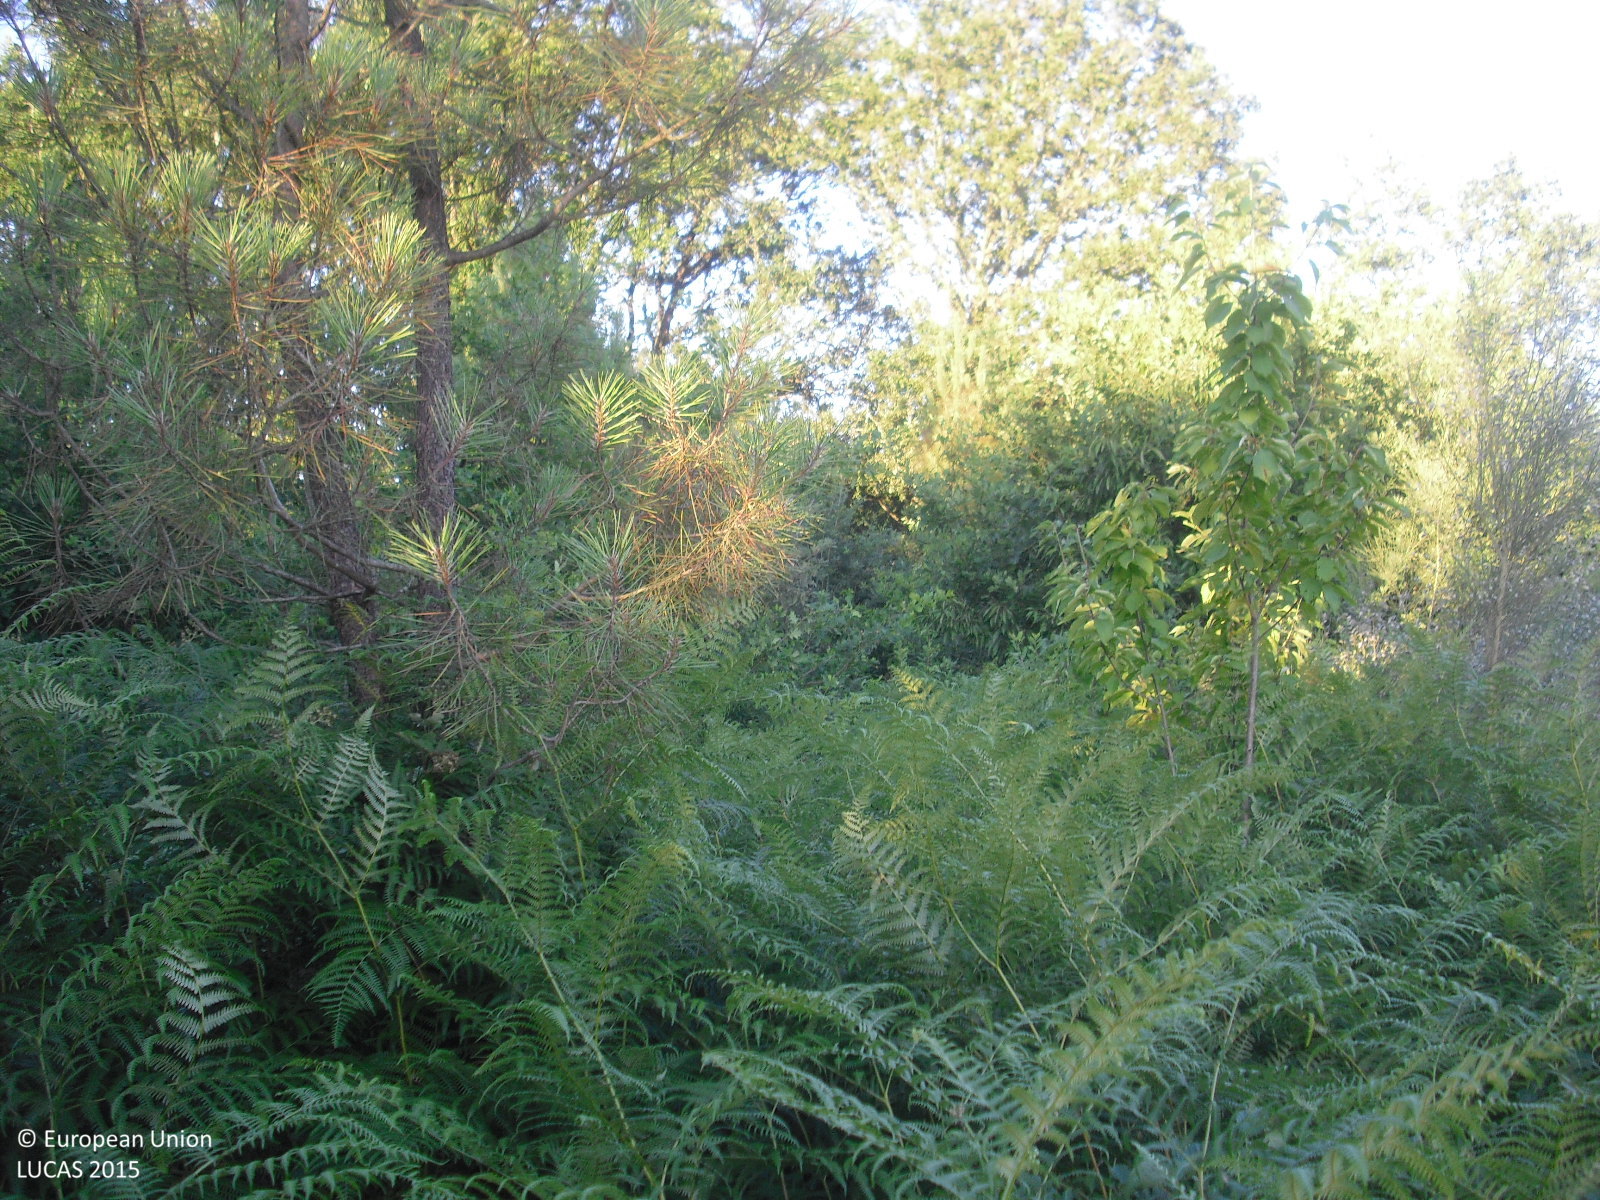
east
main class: Woodland
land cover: Broadleaved woodland
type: acidophilous oak and oak-birch forest
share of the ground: 25 - 50 %
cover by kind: shrubs 55 %, broadleaved forest trees 40 %, coniferous forest trees 5 %
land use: Semi-natural and natural areas not in use
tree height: > 5 m
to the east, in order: Broadleaved woodland; Fences; Shruby margins; Grassland without tree/shrub cover; Grassland with sparse tree/shrub cover; Temporary grasslands; Shruby margins; Broadleaved woodland; Shruby margins; Temporary grasslands; Shruby margins; Abandoned hedges; Shruby margins; Grassland without tree/shrub cover; Fences; Single bushes/trees; Shruby margins; Tracks; Abandoned hedges; Grassland without tree/shrub cover
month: July
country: ES
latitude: 42.6330
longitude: -7.4715
